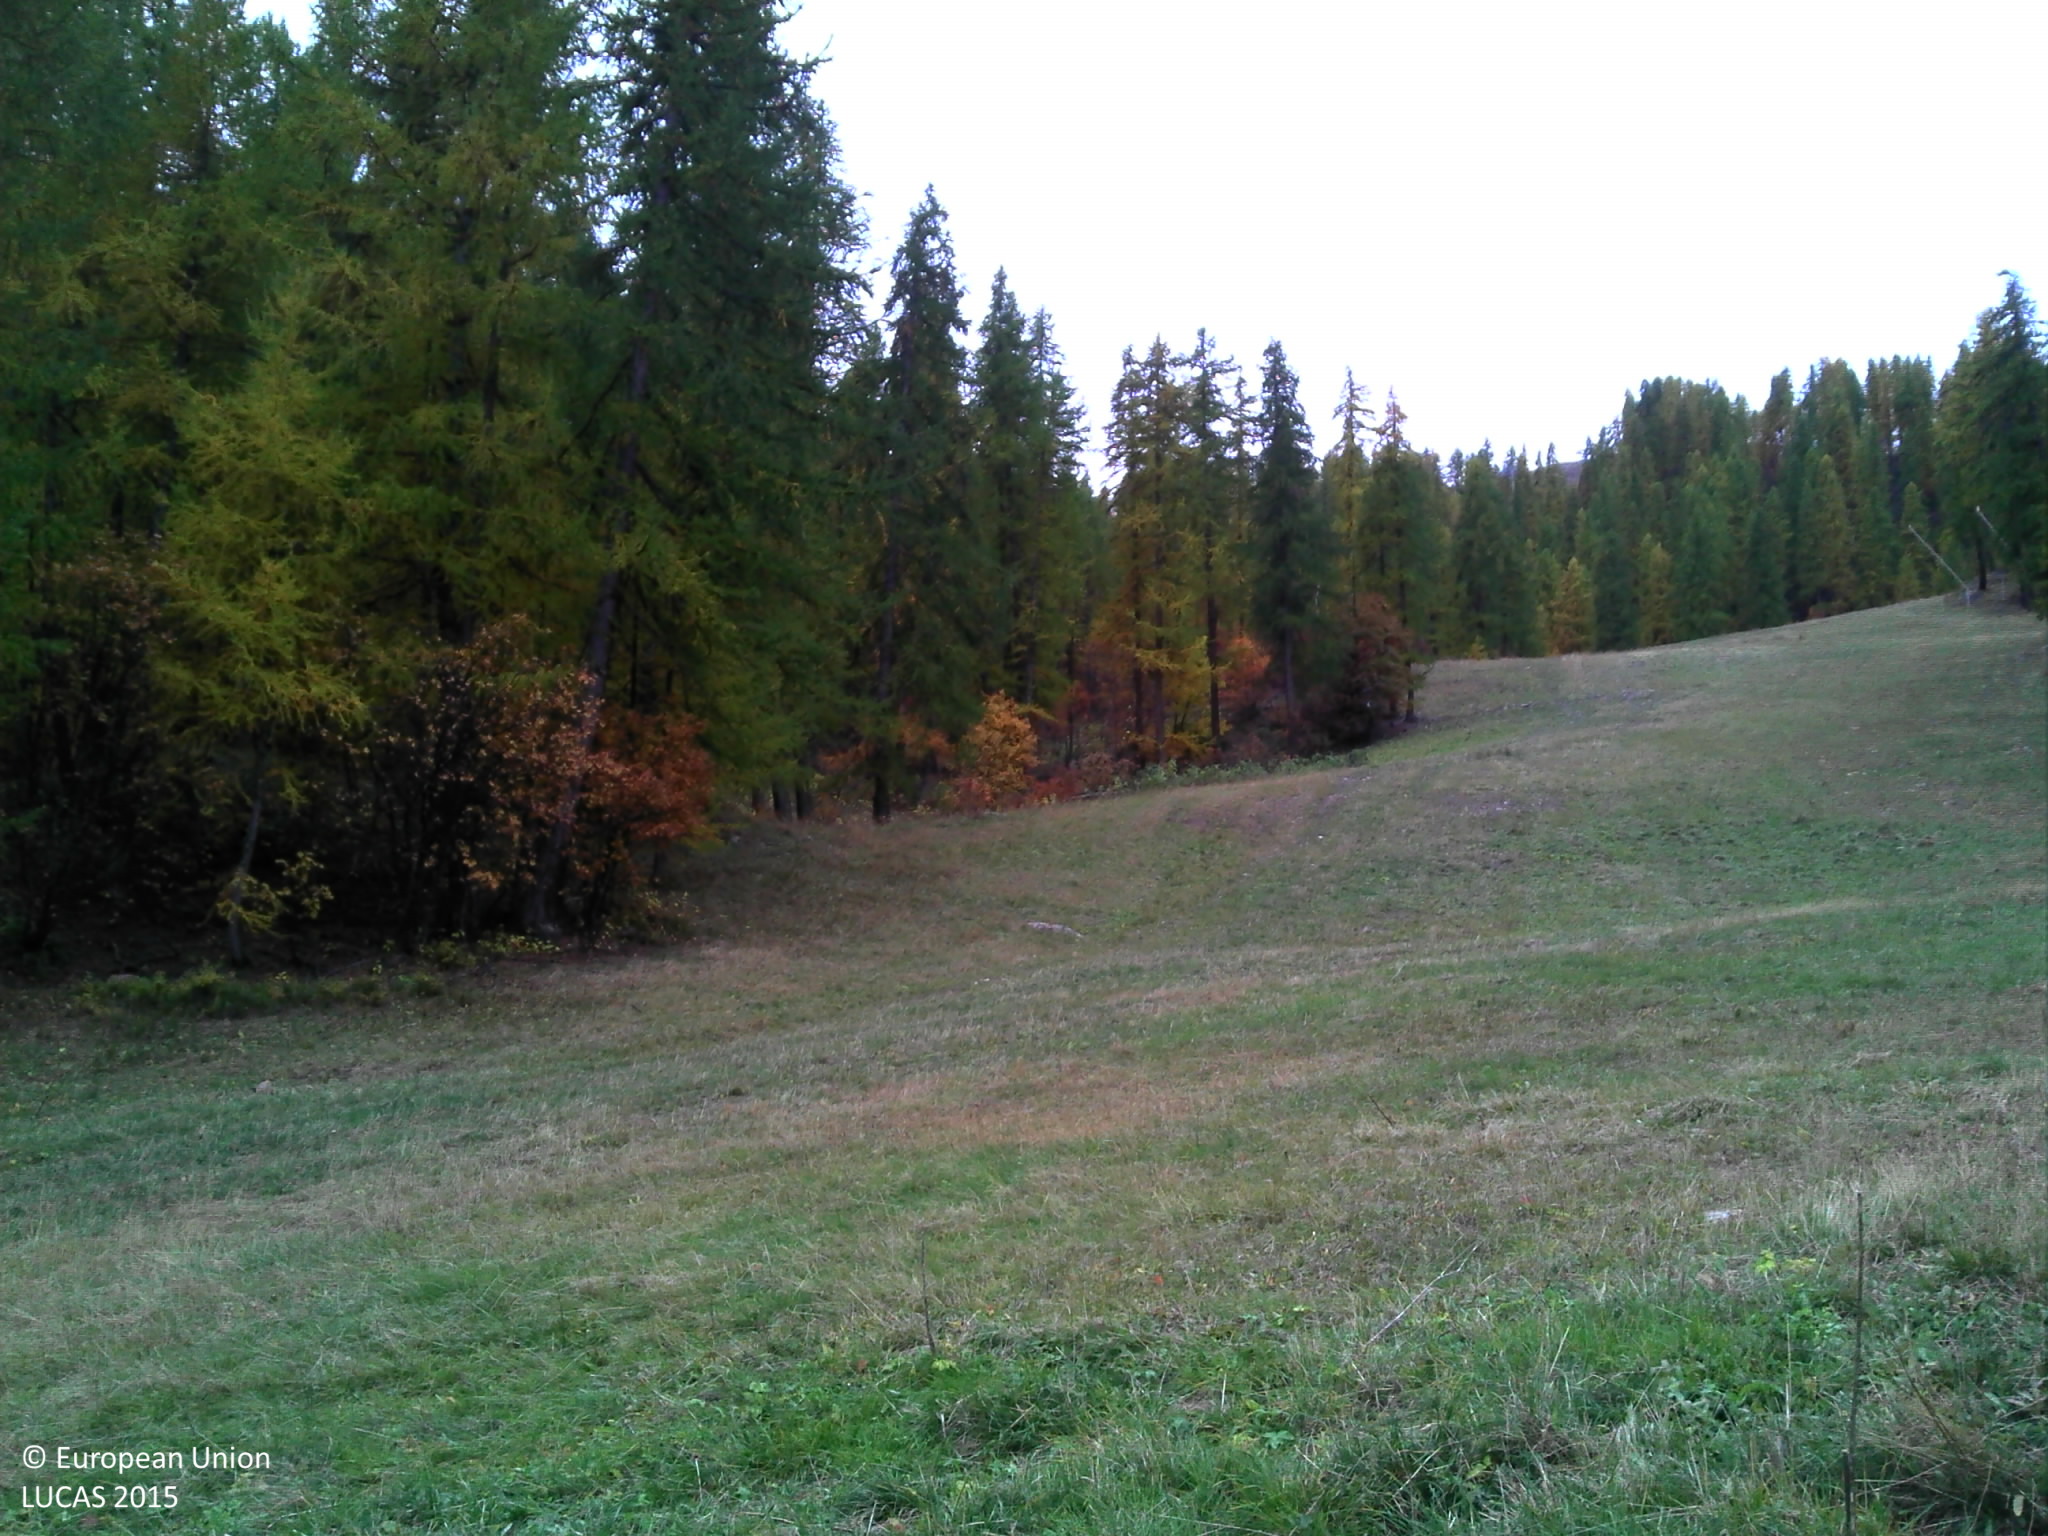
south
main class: Grassland
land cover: Grassland without tree/shrub cover
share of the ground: > 75 %
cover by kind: herbaceous plants 95 %, unconsolidated bare surface 5 %
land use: Agriculture (excluding fallow land and kitchen gardens)
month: October
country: FR
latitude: 44.8142
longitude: 6.4778
